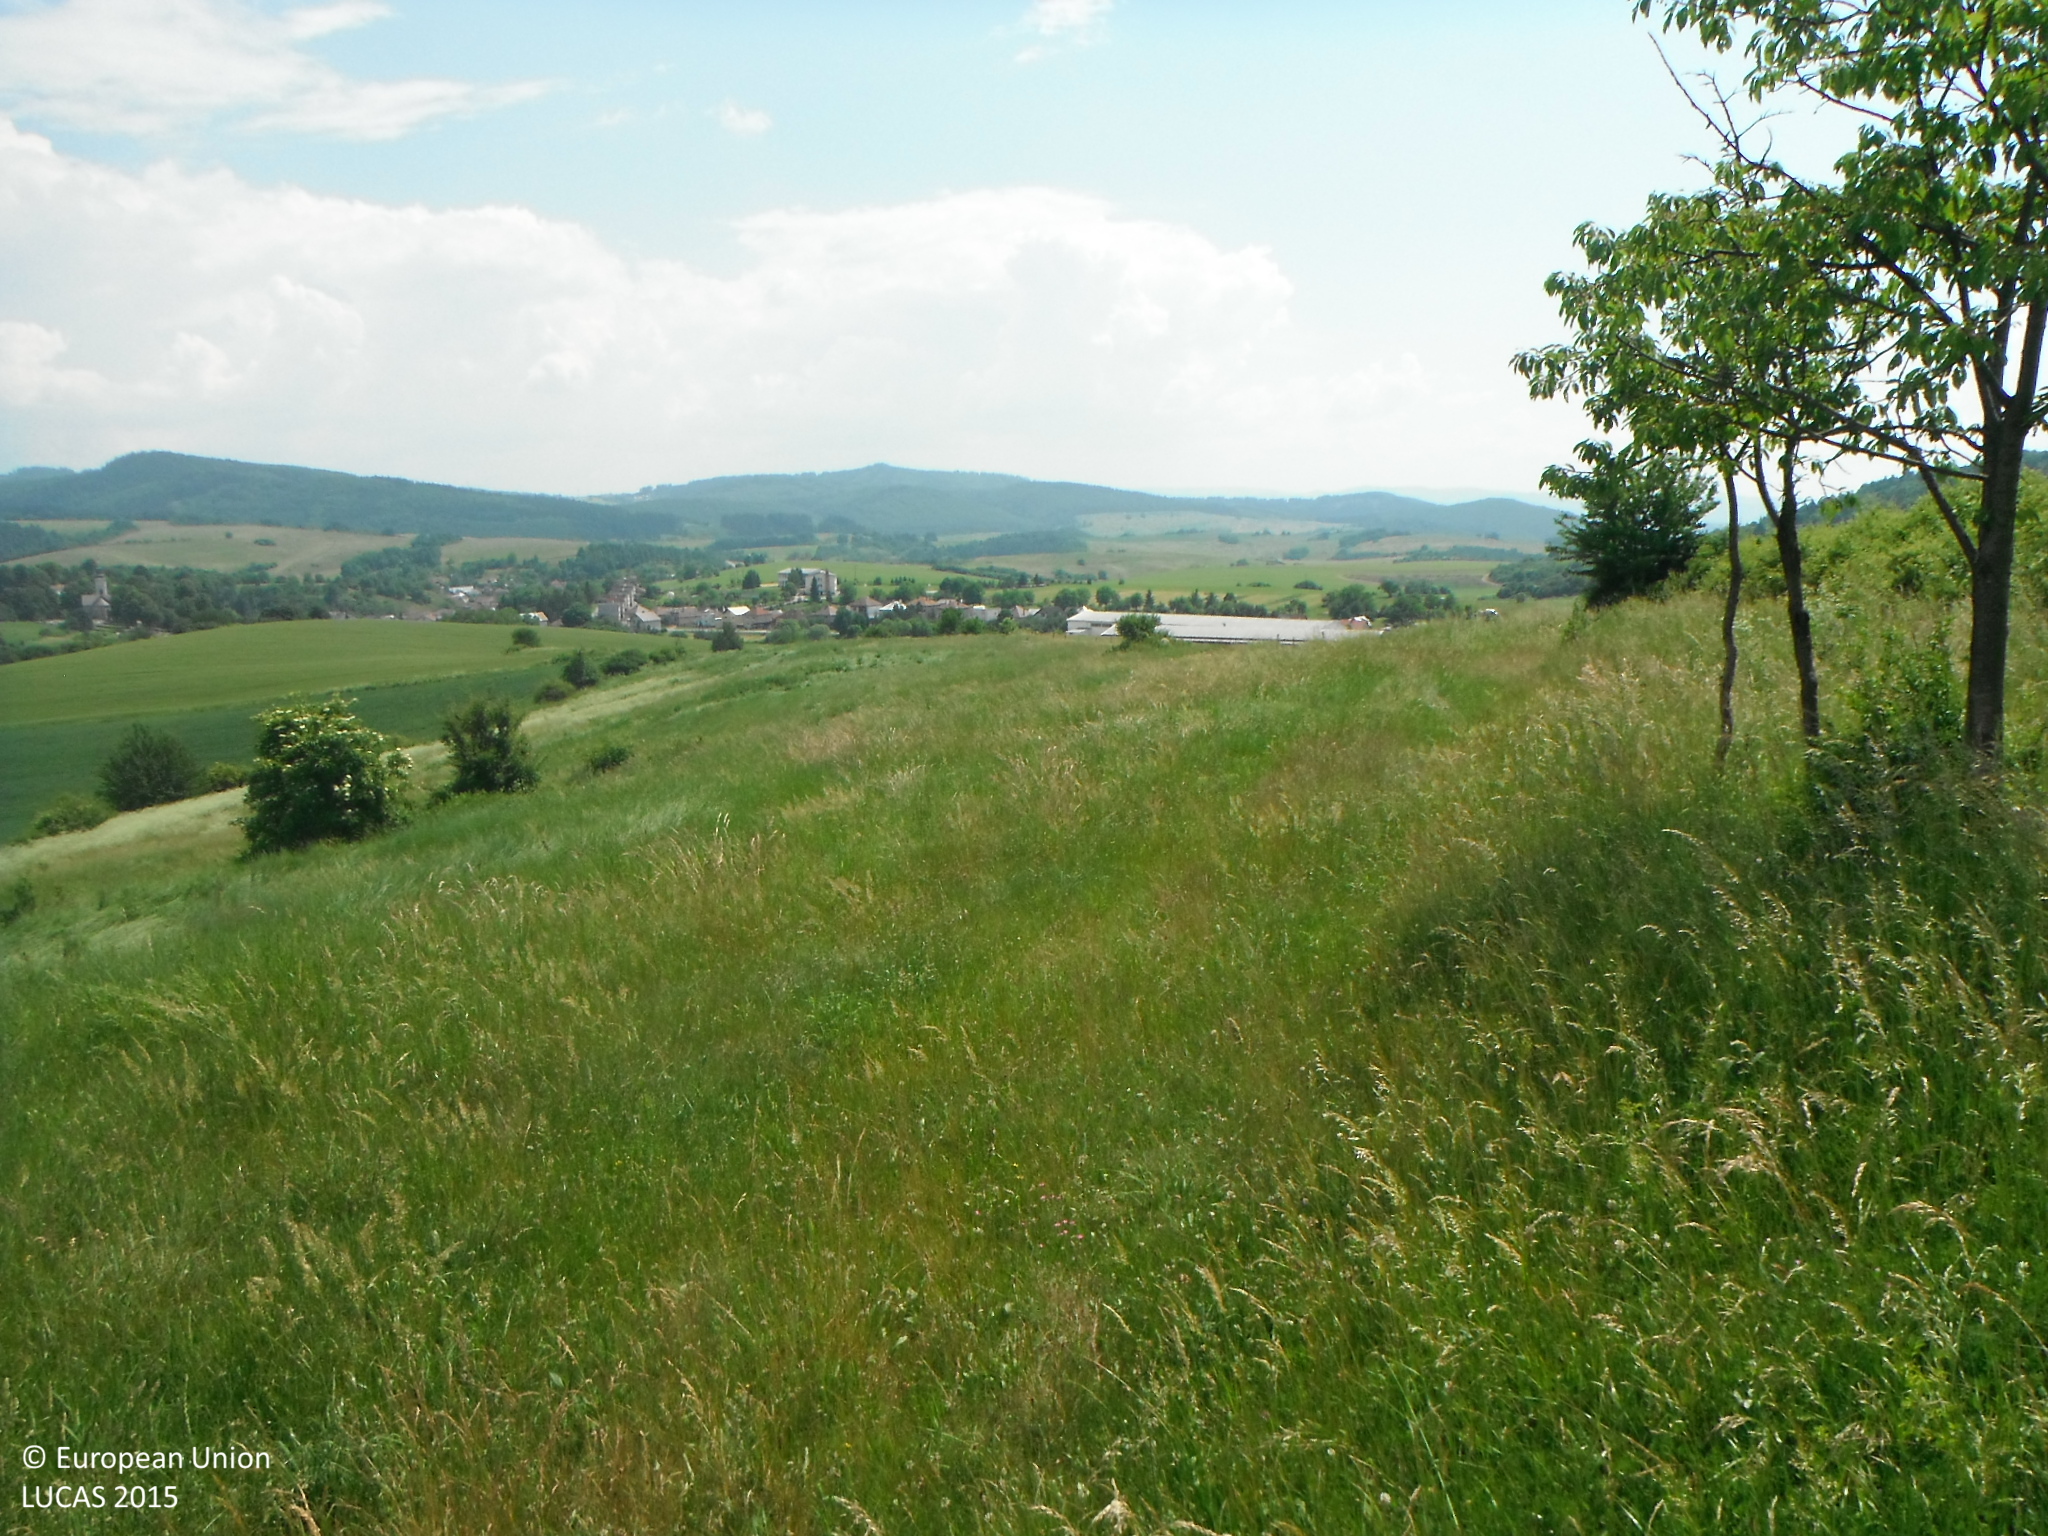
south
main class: Grassland
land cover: Grassland without tree/shrub cover
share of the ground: > 75 %
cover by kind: herbaceous plants 100 %
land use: Agriculture (excluding fallow land and kitchen gardens)
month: June
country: SK
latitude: 48.7188
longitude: 19.2798
